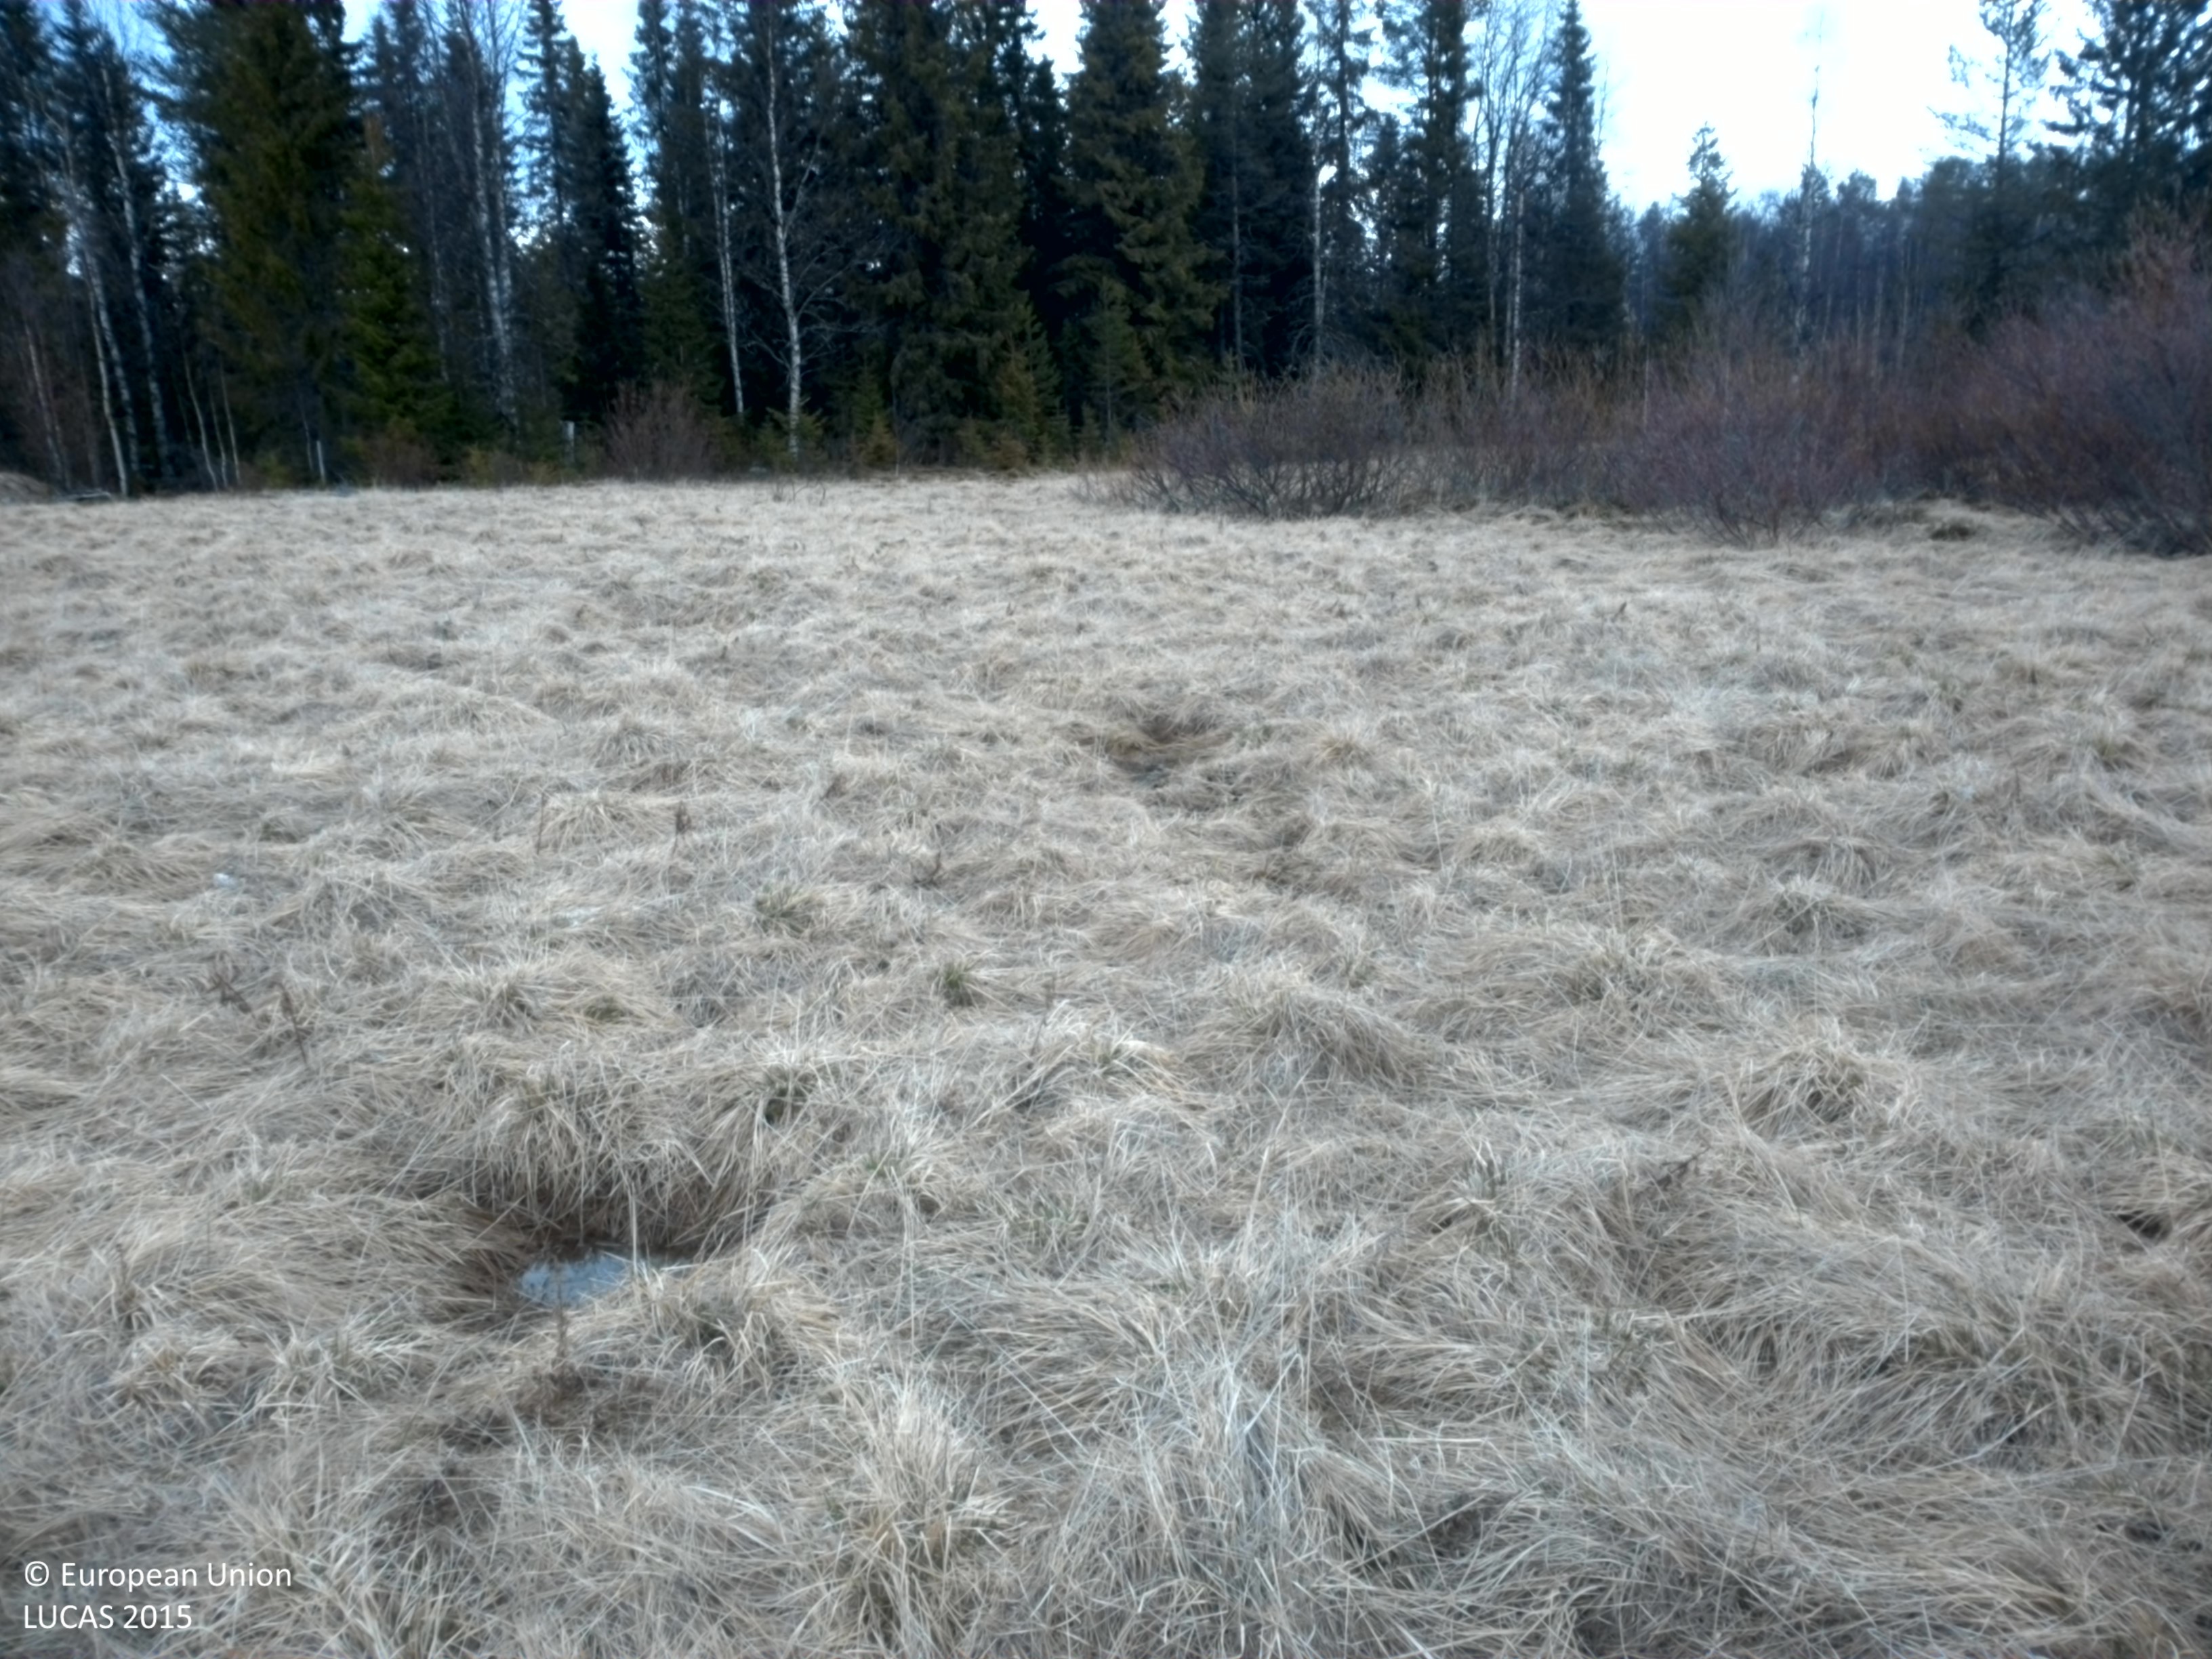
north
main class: Grassland
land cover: Grassland without tree/shrub cover
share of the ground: > 75 %
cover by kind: herbaceous plants 100 %
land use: Abandoned areas
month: May
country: SE
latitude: 64.2900
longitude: 18.2956
